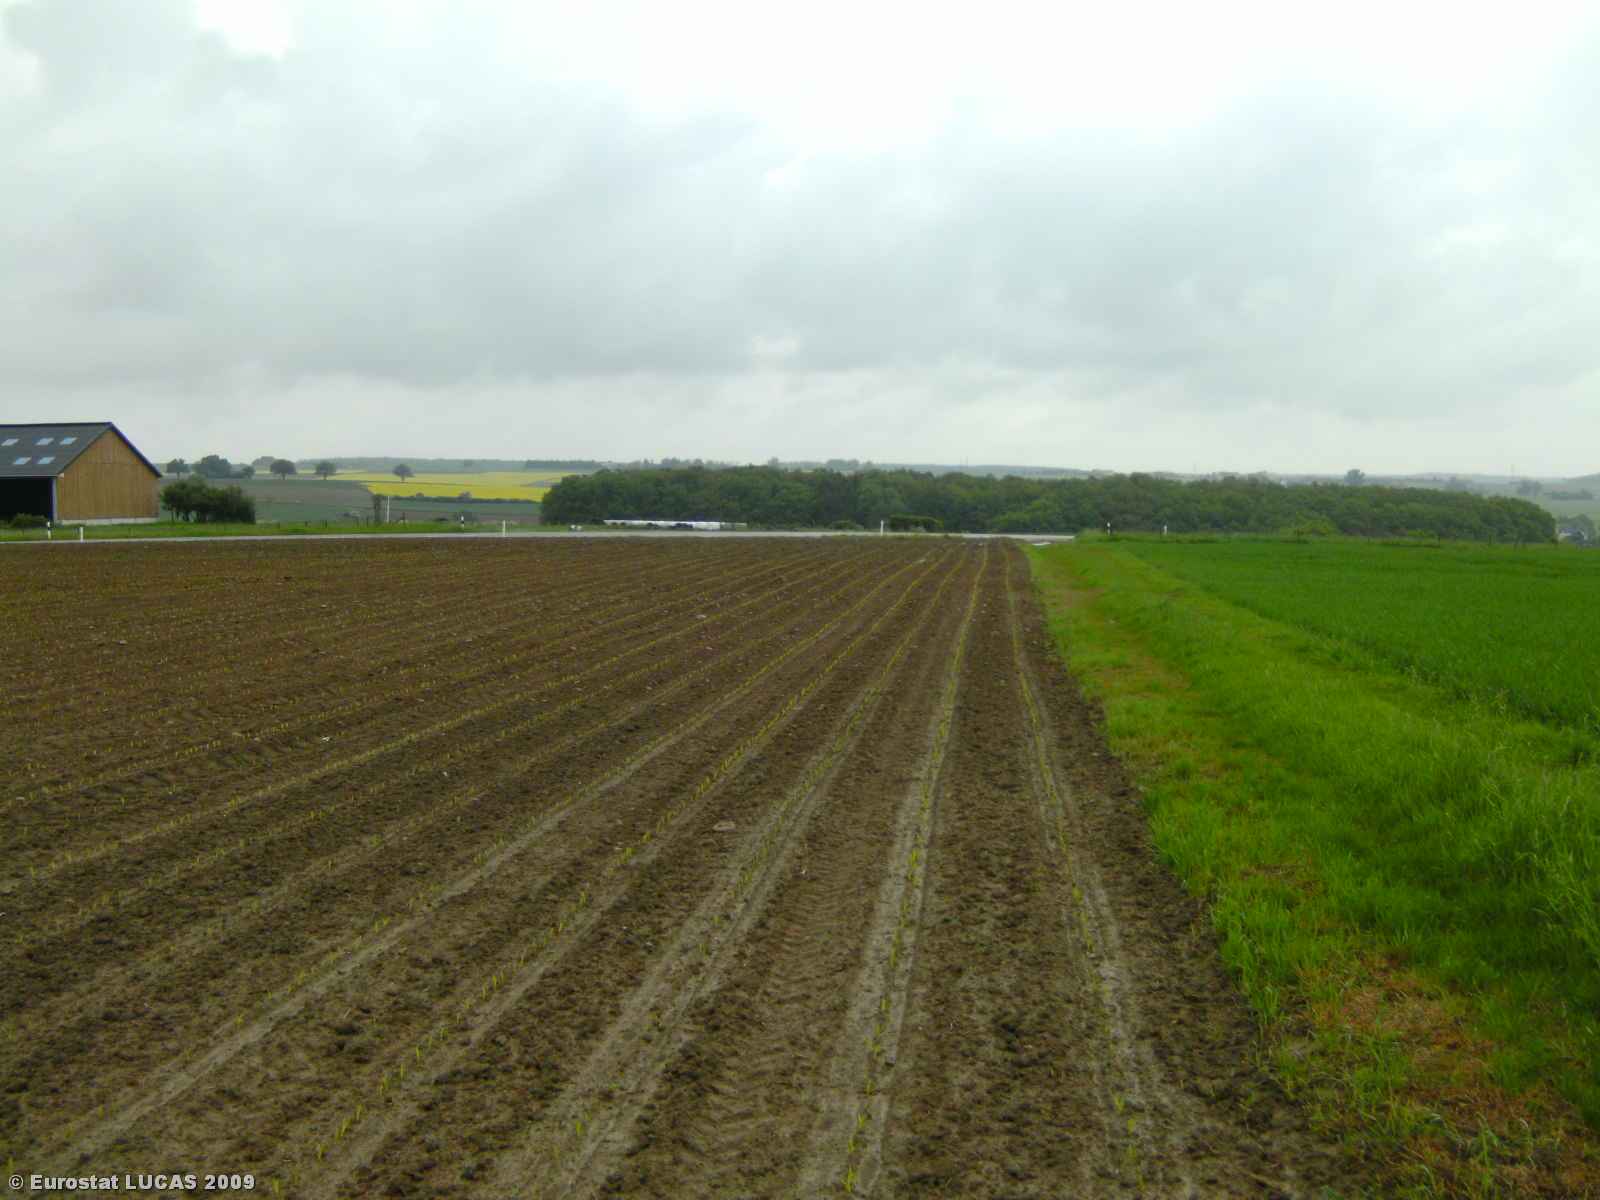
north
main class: Cropland
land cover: Maize
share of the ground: < 10 %
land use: Agriculture (excluding fallow land and kitchen gardens)
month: May
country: LU
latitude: 49.7810
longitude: 6.2637
